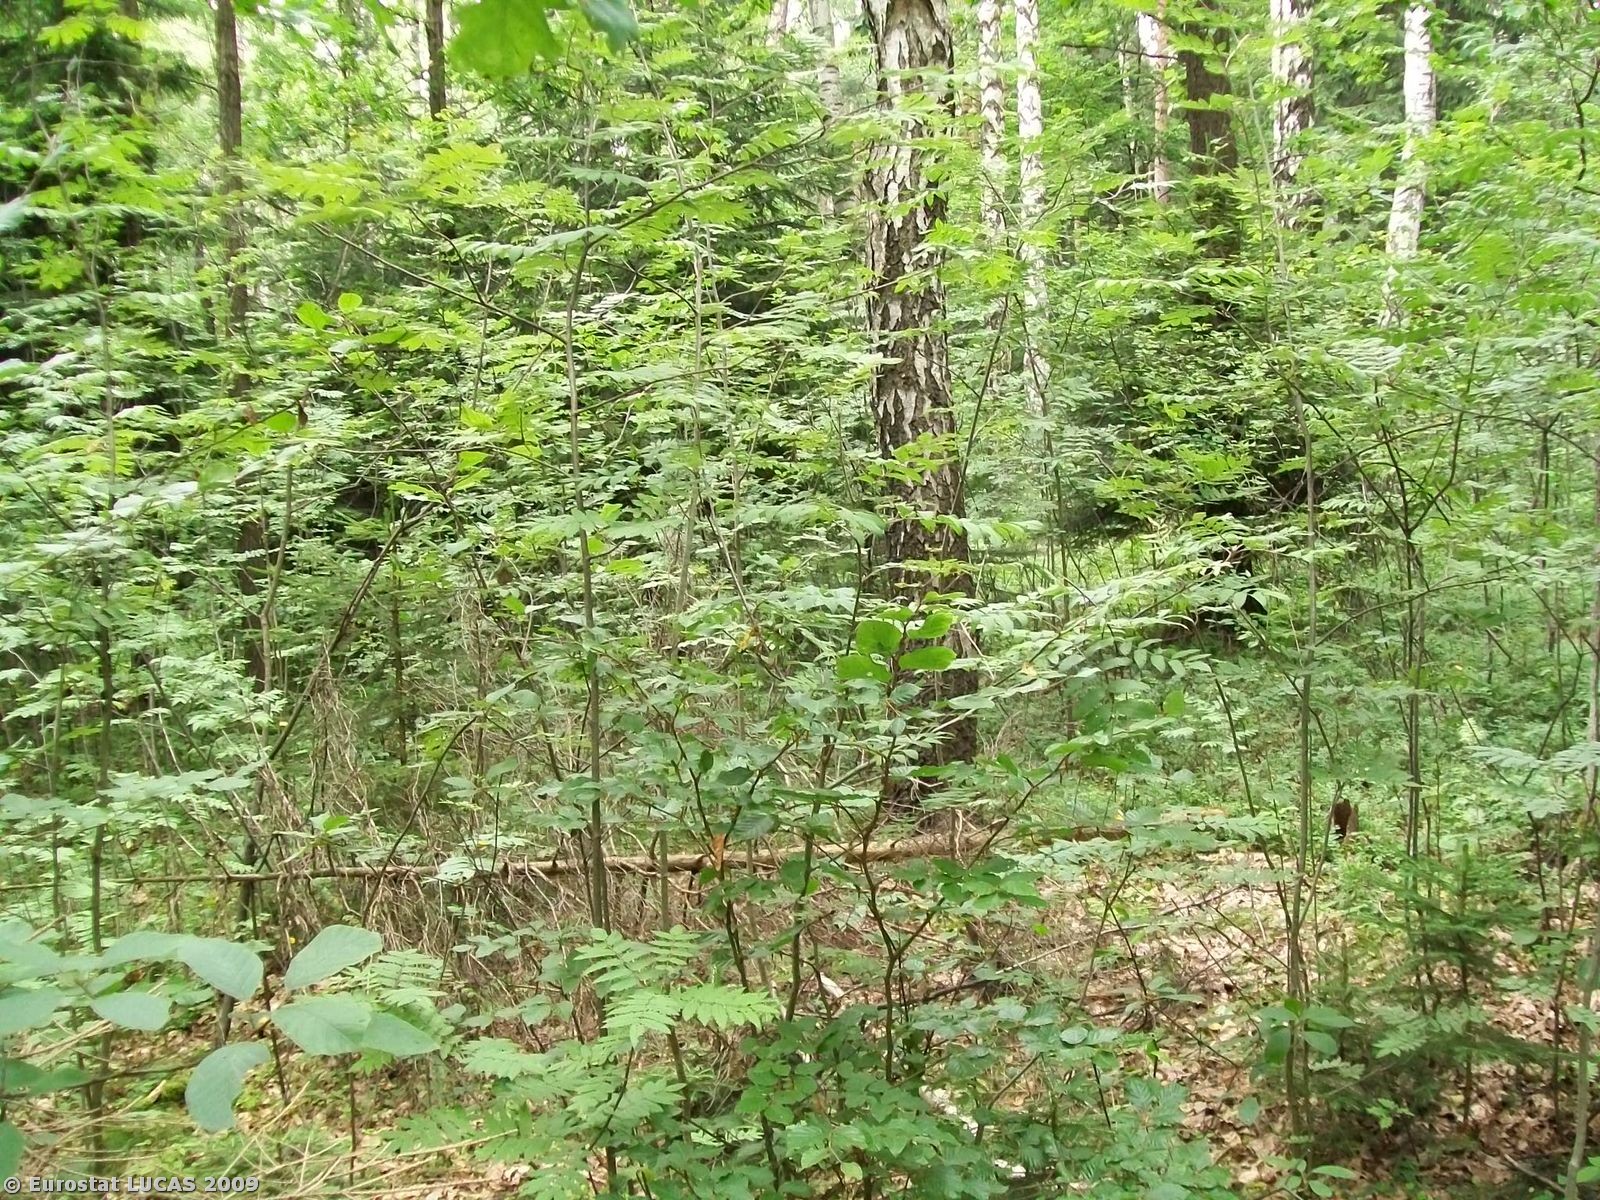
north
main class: Woodland
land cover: Mixed woodland
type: hemiboreal forest and nemoral coniferous forest and mixed broadleaved-coniferous forest
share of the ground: > 75 %
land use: Forestry
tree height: > 5 m
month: July
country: PL
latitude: 51.0228
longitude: 15.1500
